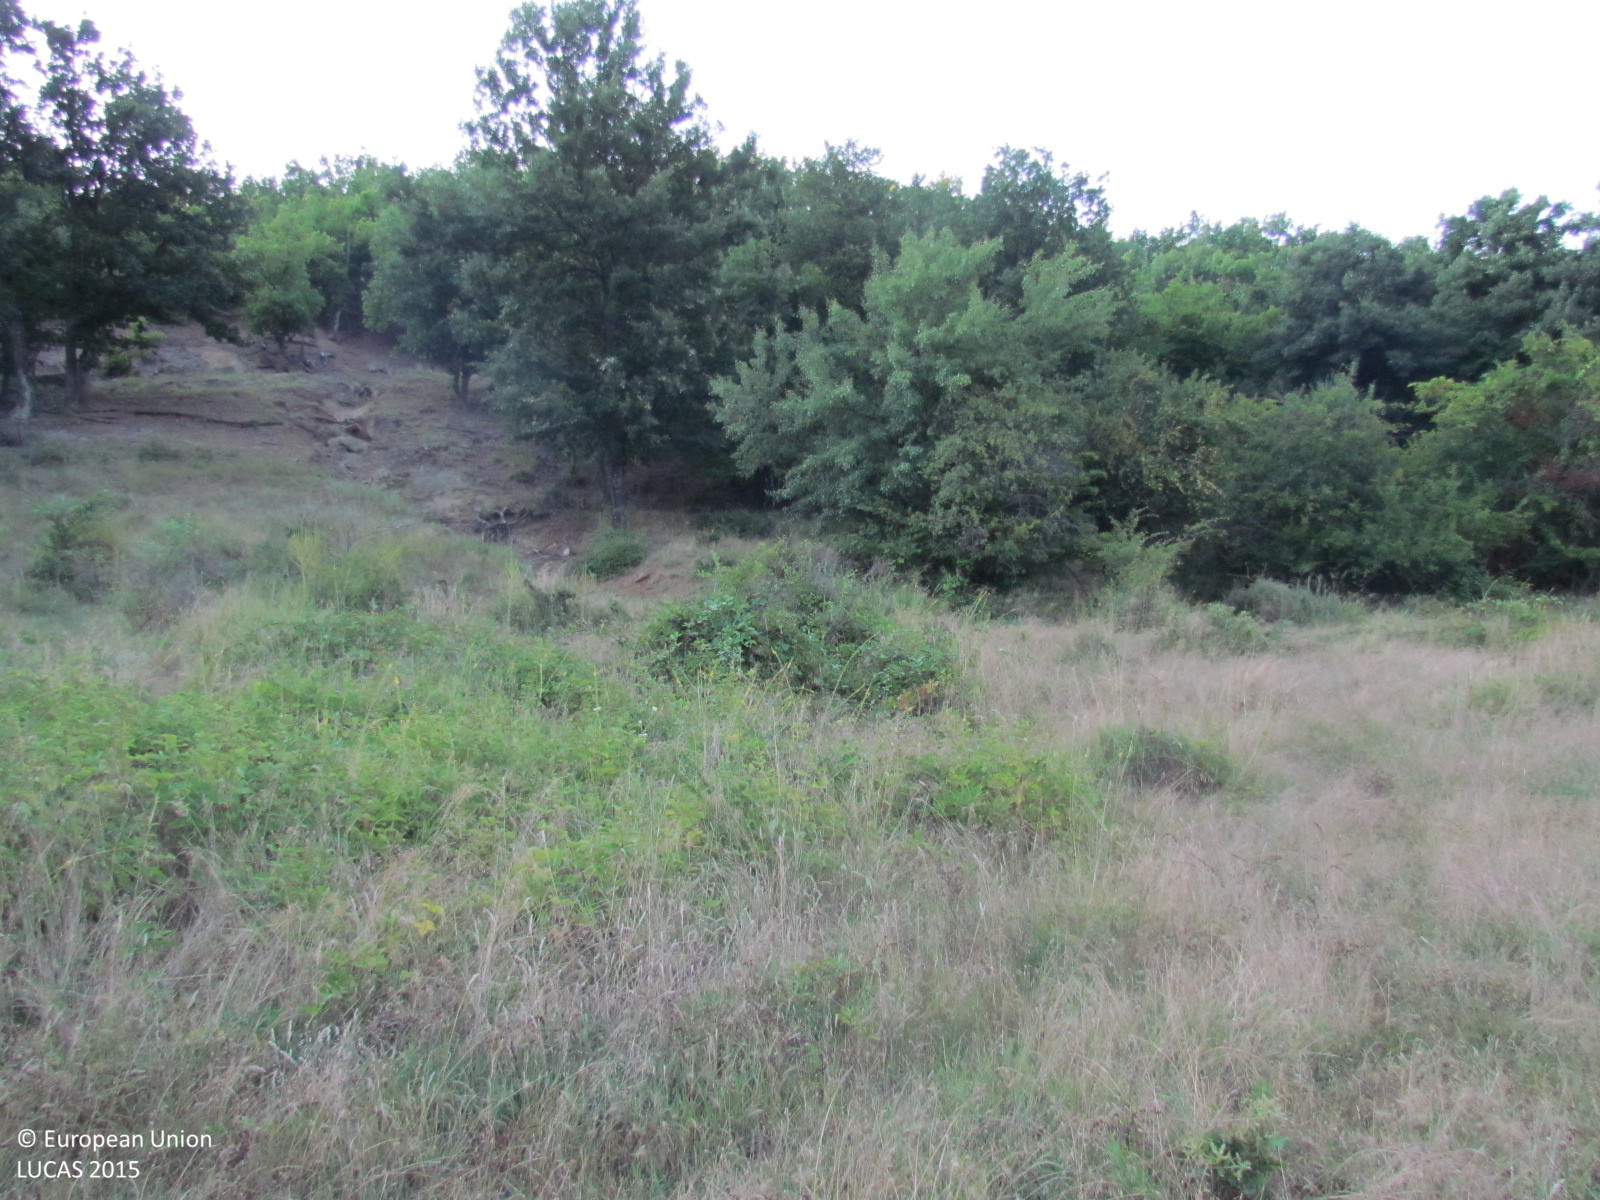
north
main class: Grassland
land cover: Grassland with sparse tree/shrub cover
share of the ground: > 75 %
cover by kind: herbaceous plants 85 %, shrubs 10 %, broadleaved forest trees 5 %
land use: Agriculture (excluding fallow land and kitchen gardens)
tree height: < 5 m
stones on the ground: < 10 %
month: July
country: BG
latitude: 42.8956
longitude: 27.5507
